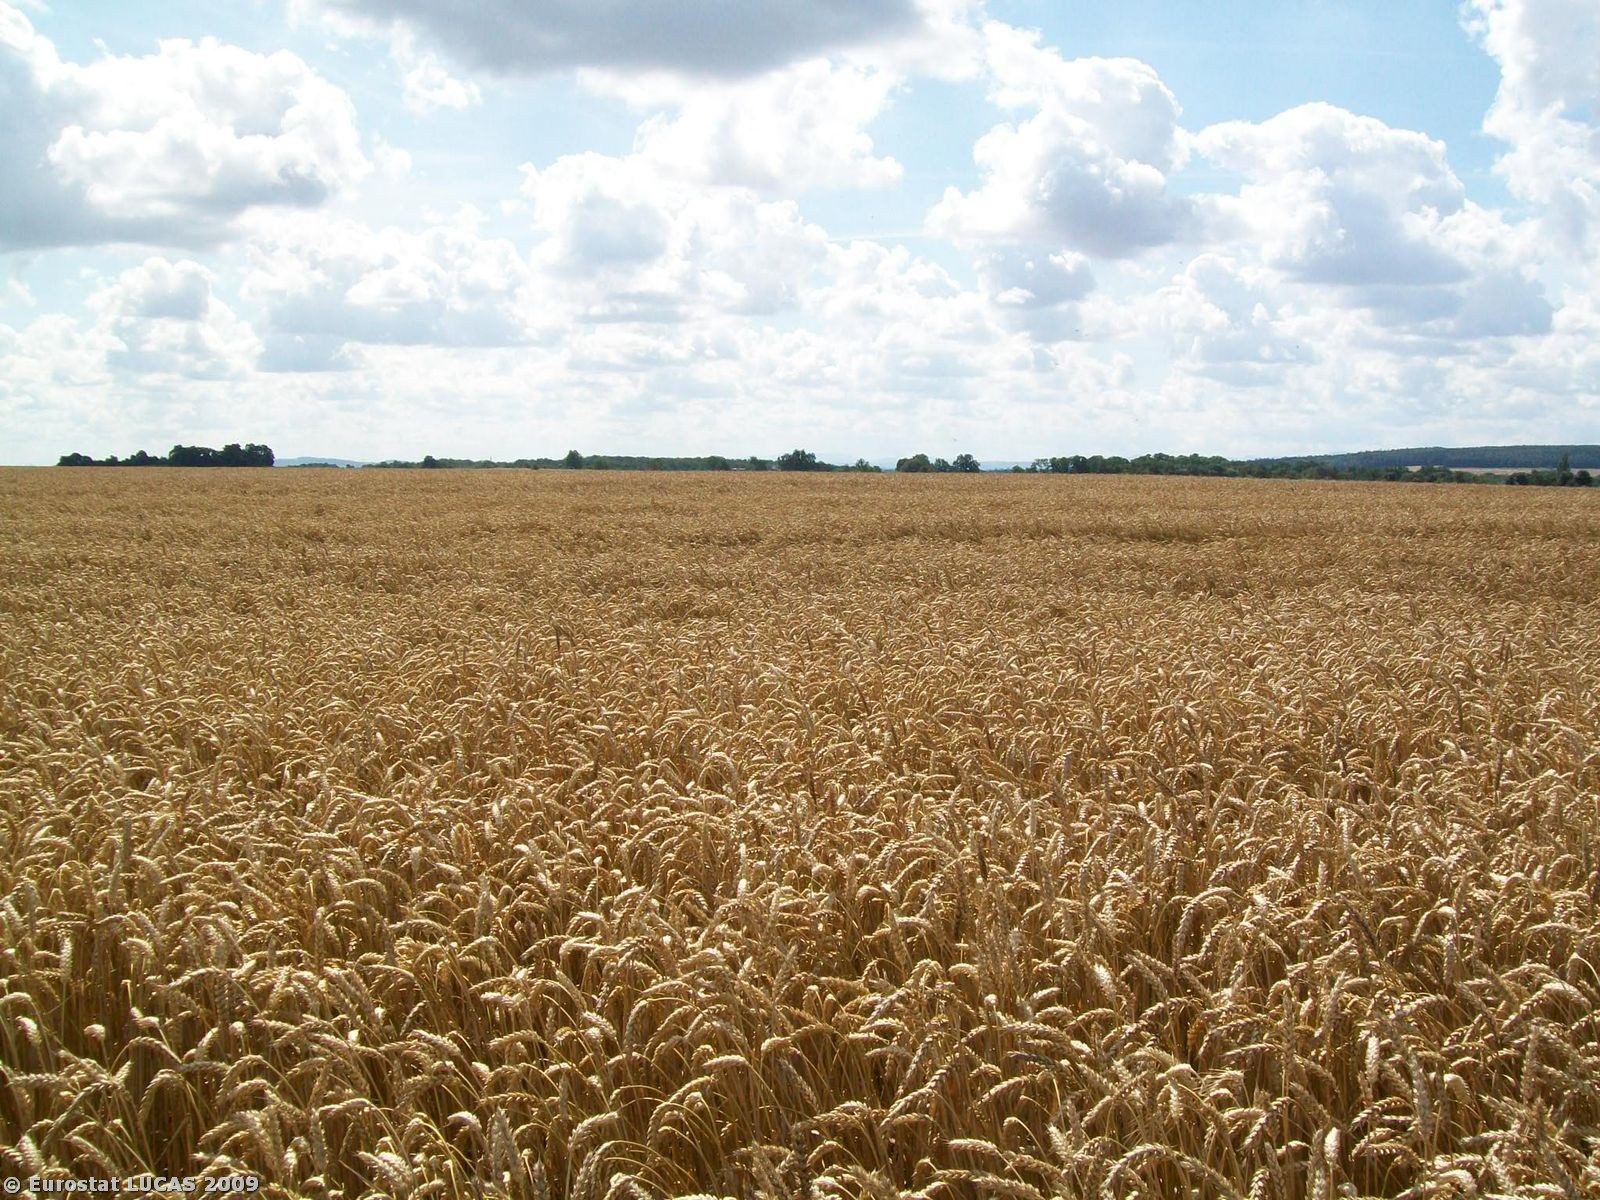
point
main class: Cropland
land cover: Common wheat
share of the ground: > 75 %
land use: Agriculture (excluding fallow land and kitchen gardens)
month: July
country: PL
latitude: 51.1205
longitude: 16.1068
